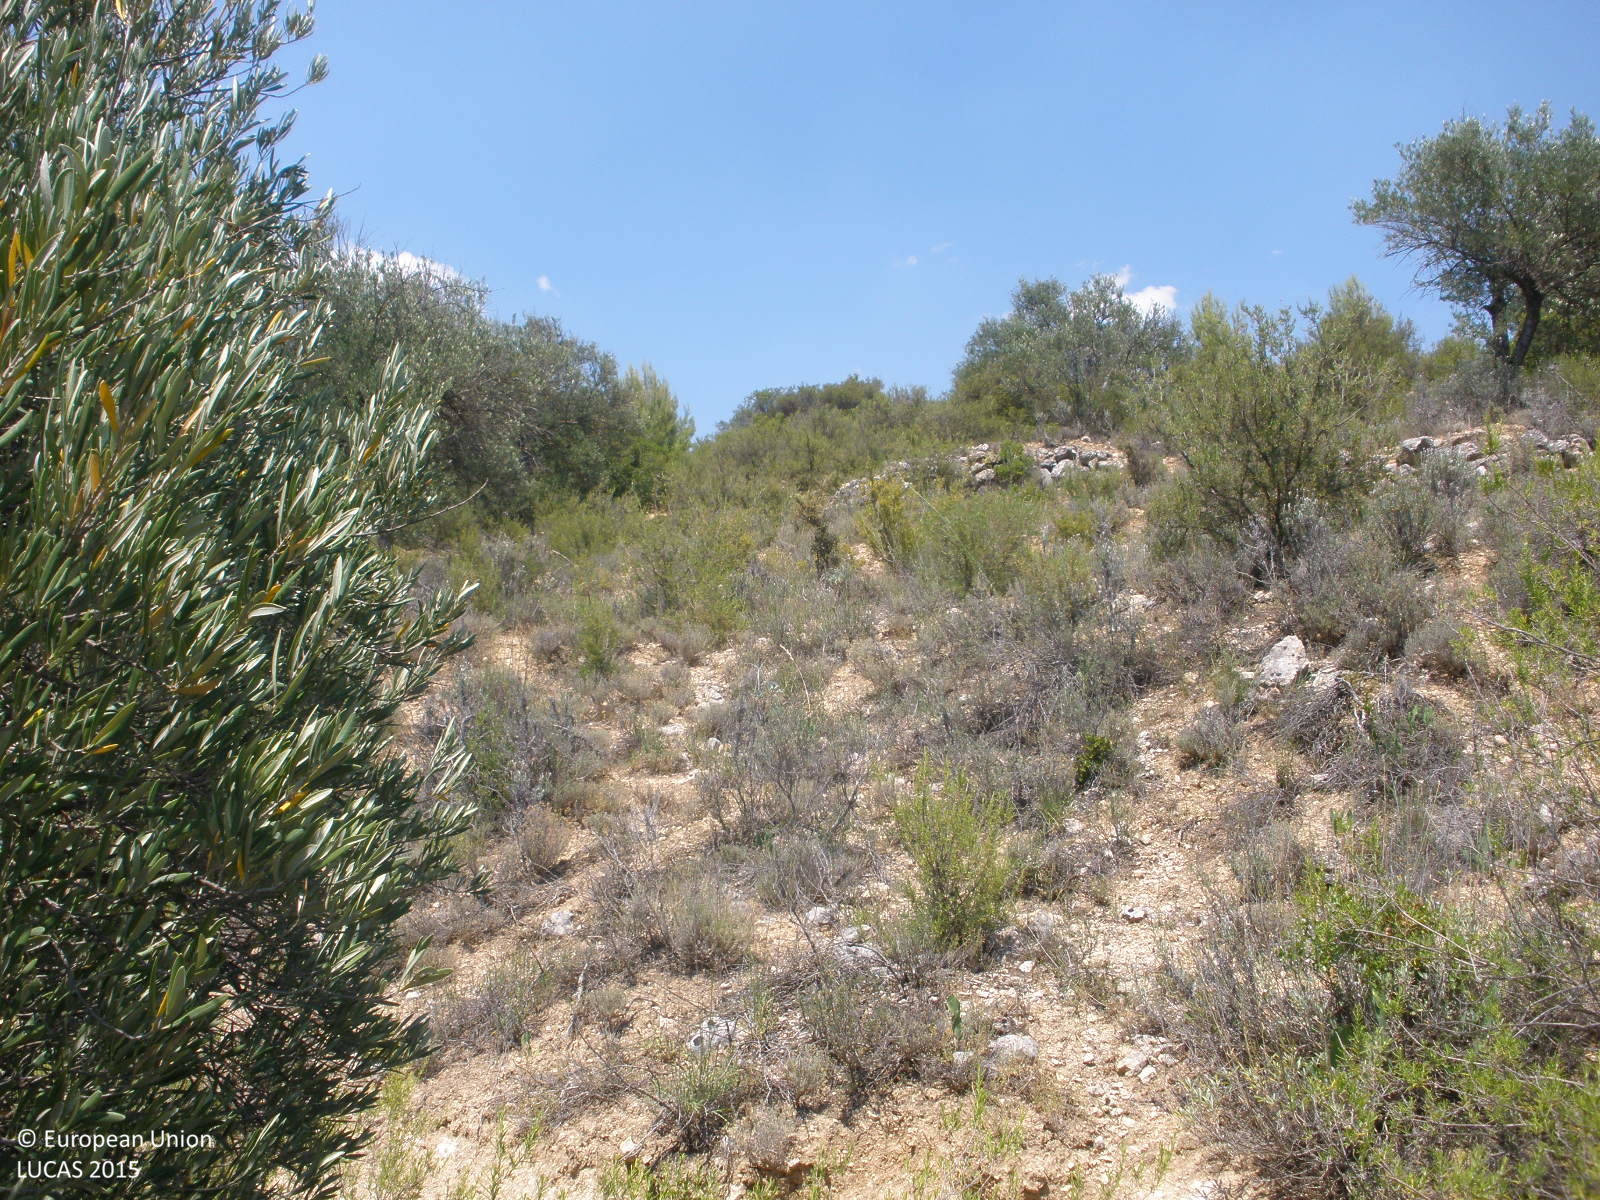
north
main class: Cropland
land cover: Olive groves
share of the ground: 50 - 75 %
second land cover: Shrubland without tree cover
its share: > 75 %
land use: Agriculture (excluding fallow land and kitchen gardens)
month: June
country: ES
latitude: 40.2037
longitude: -3.2696
